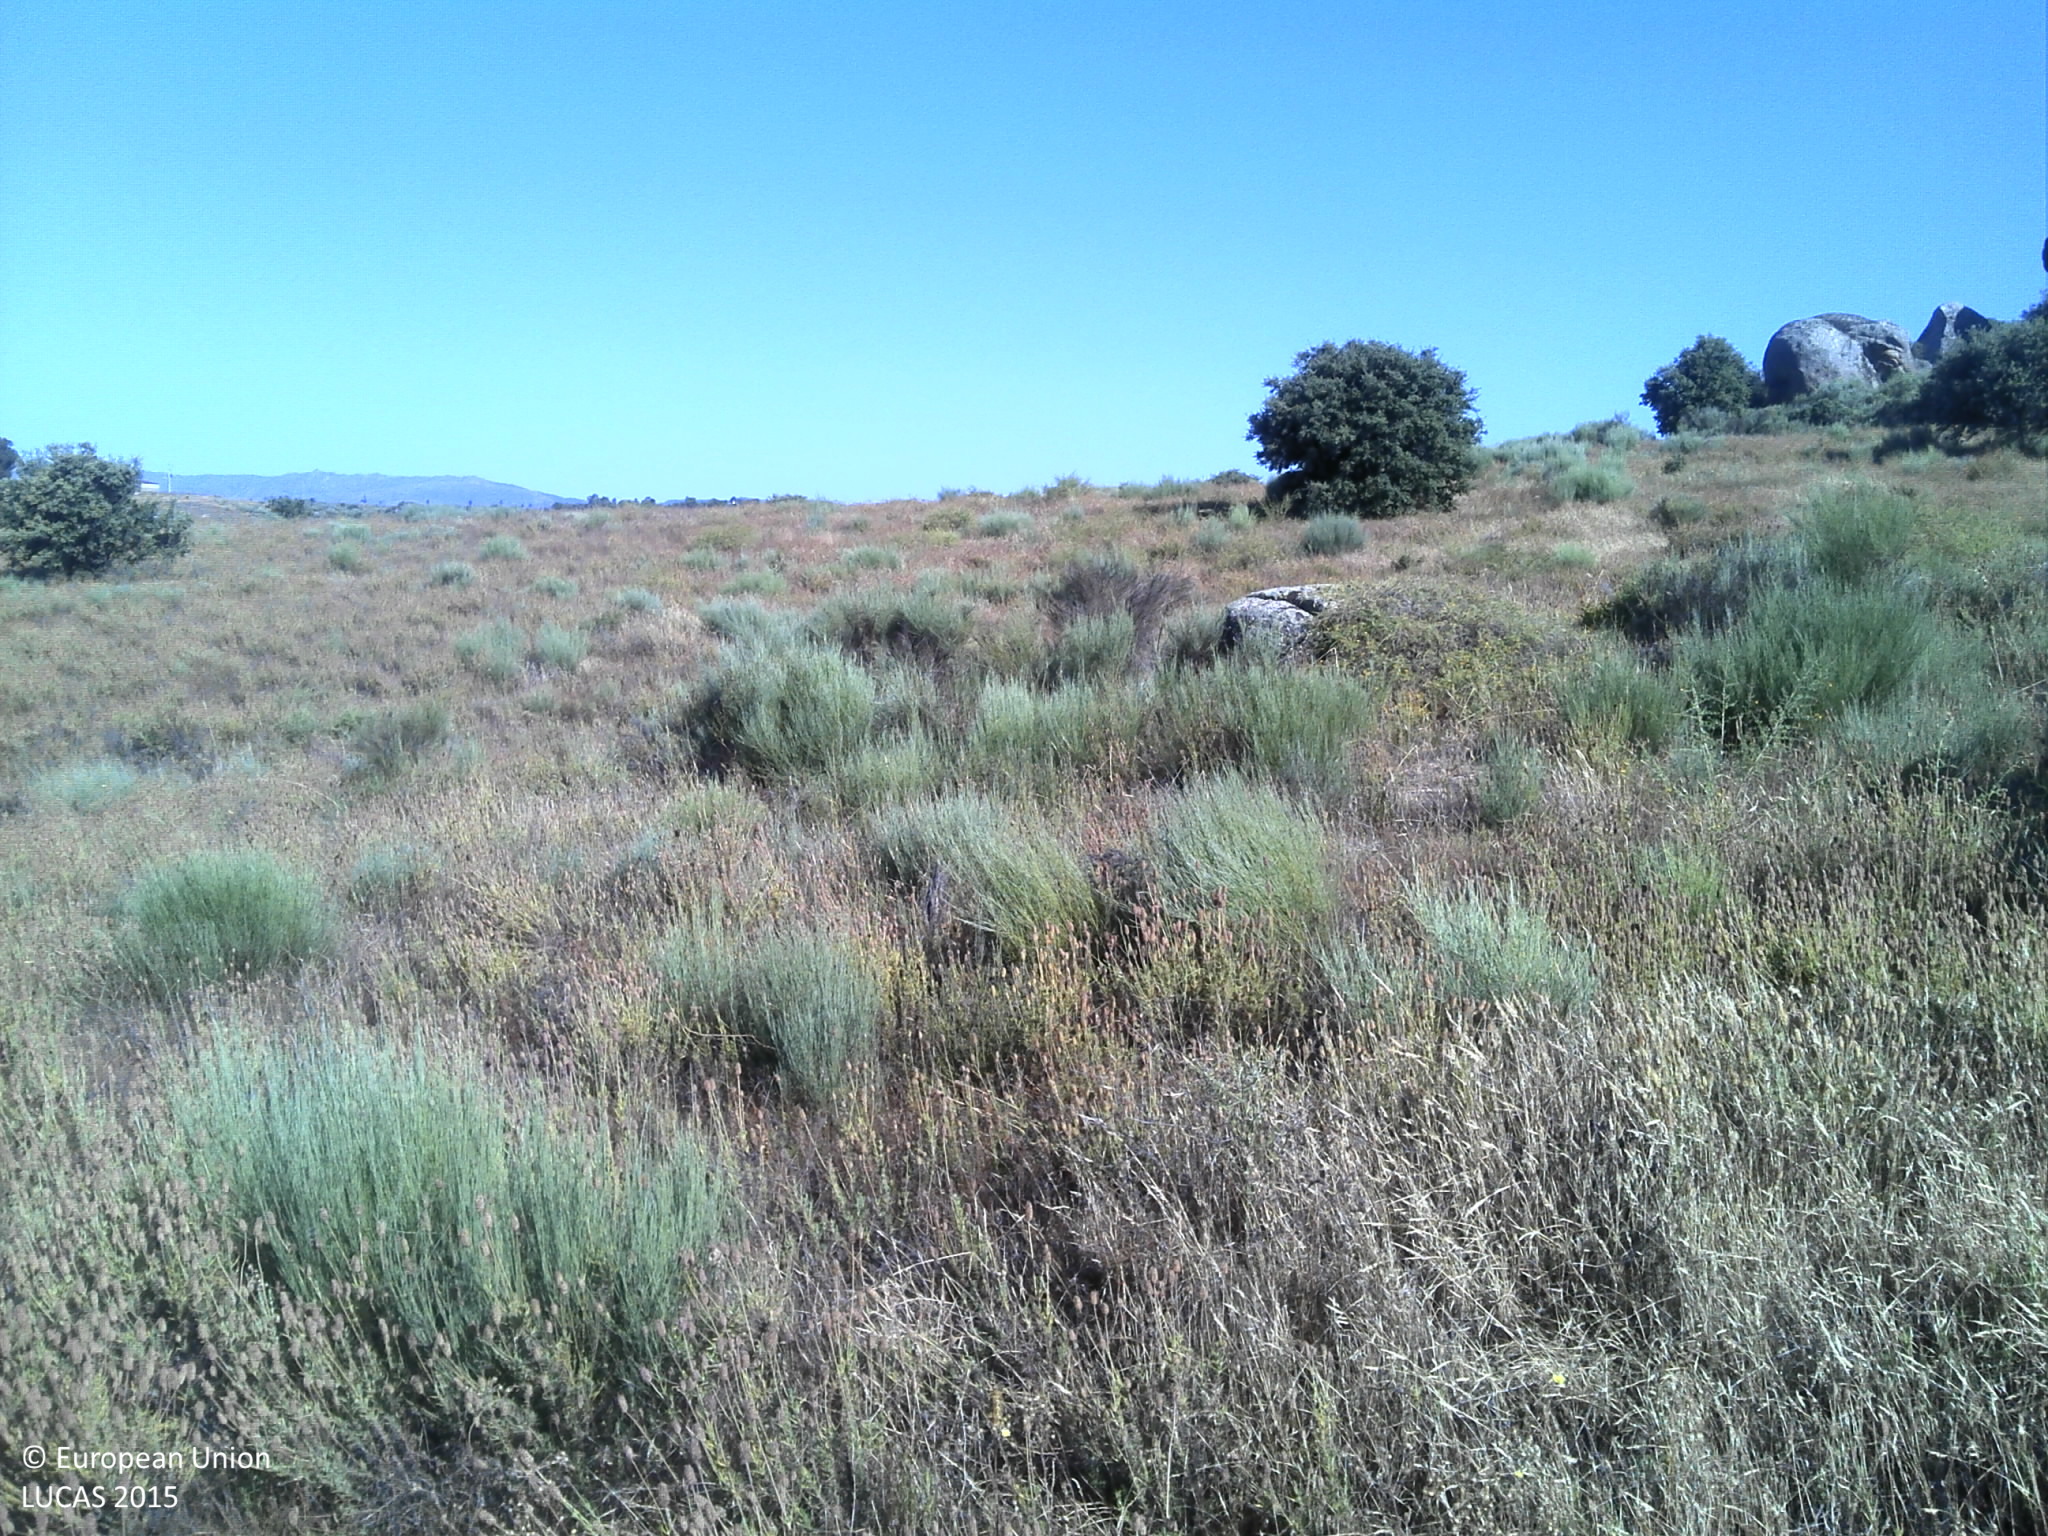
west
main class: Shrubland
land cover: Shrubland with sparse tree cover
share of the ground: 50 - 75 %
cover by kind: shrubs 40 %, herbaceous plants 25 %, unconsolidated bare surface 25 %, broadleaved forest trees 5 %
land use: Agriculture (excluding fallow land and kitchen gardens)
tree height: > 5 m
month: June
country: PT
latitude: 40.0604
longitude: -7.3210
